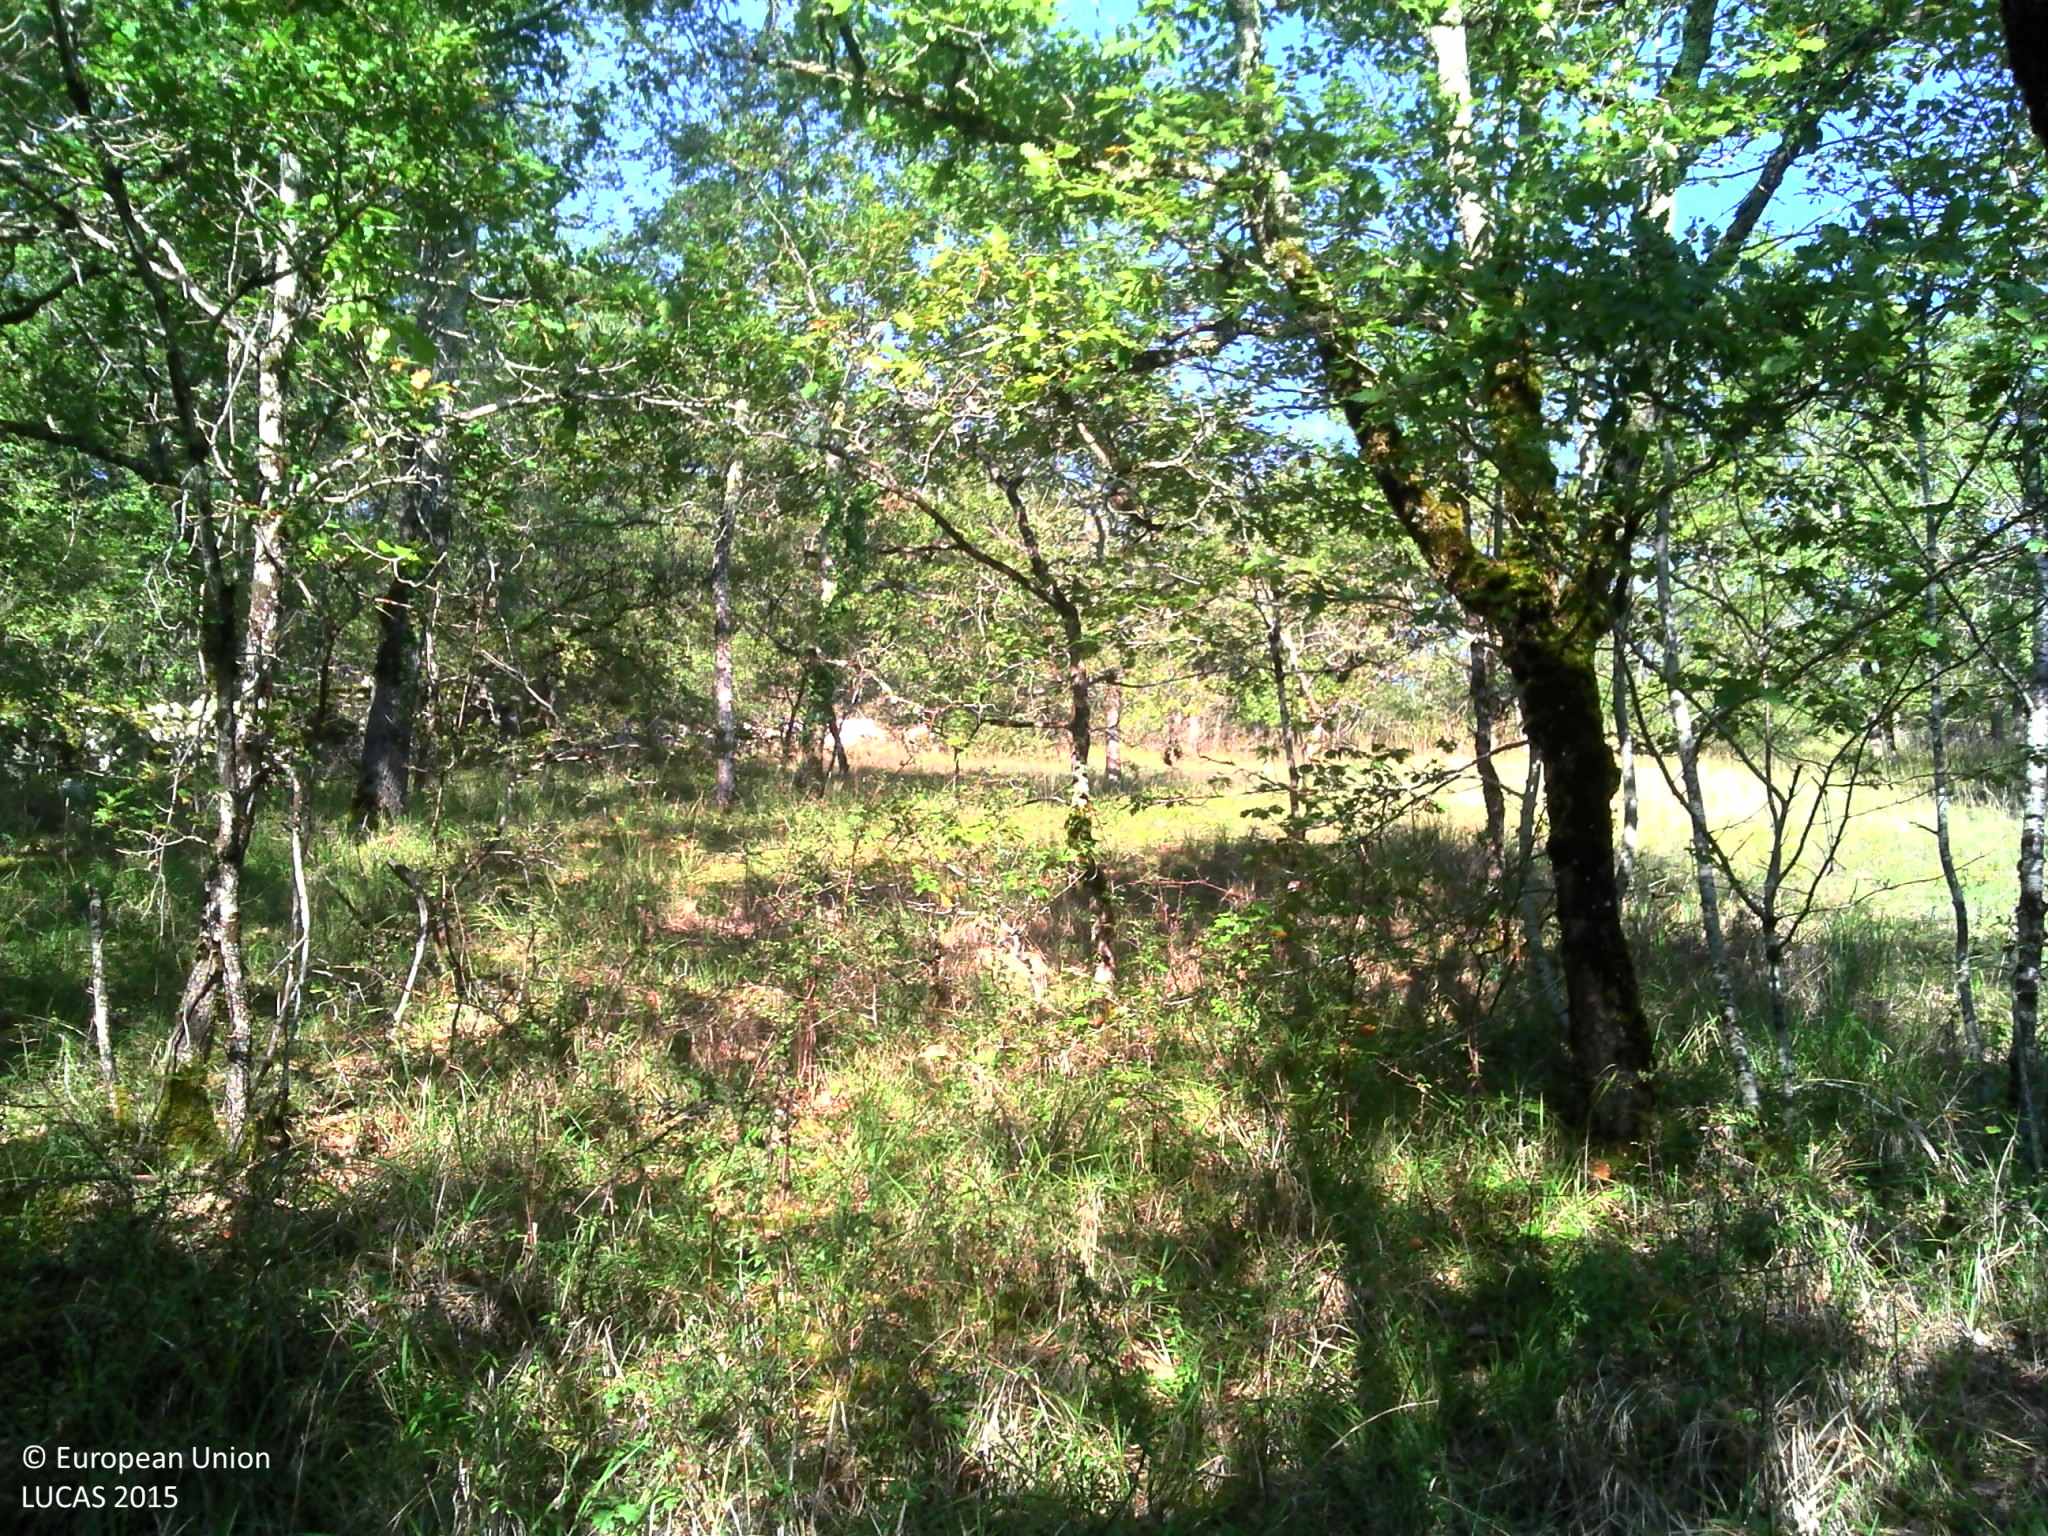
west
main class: Woodland
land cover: Broadleaved woodland
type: thermophilous deciduous forest
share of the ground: > 75 %
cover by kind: broadleaved forest trees 60 %, shrubs 20 %, herbaceous plants 20 %
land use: Forestry
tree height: > 5 m
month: September
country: FR
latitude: 44.6697
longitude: 1.2548
